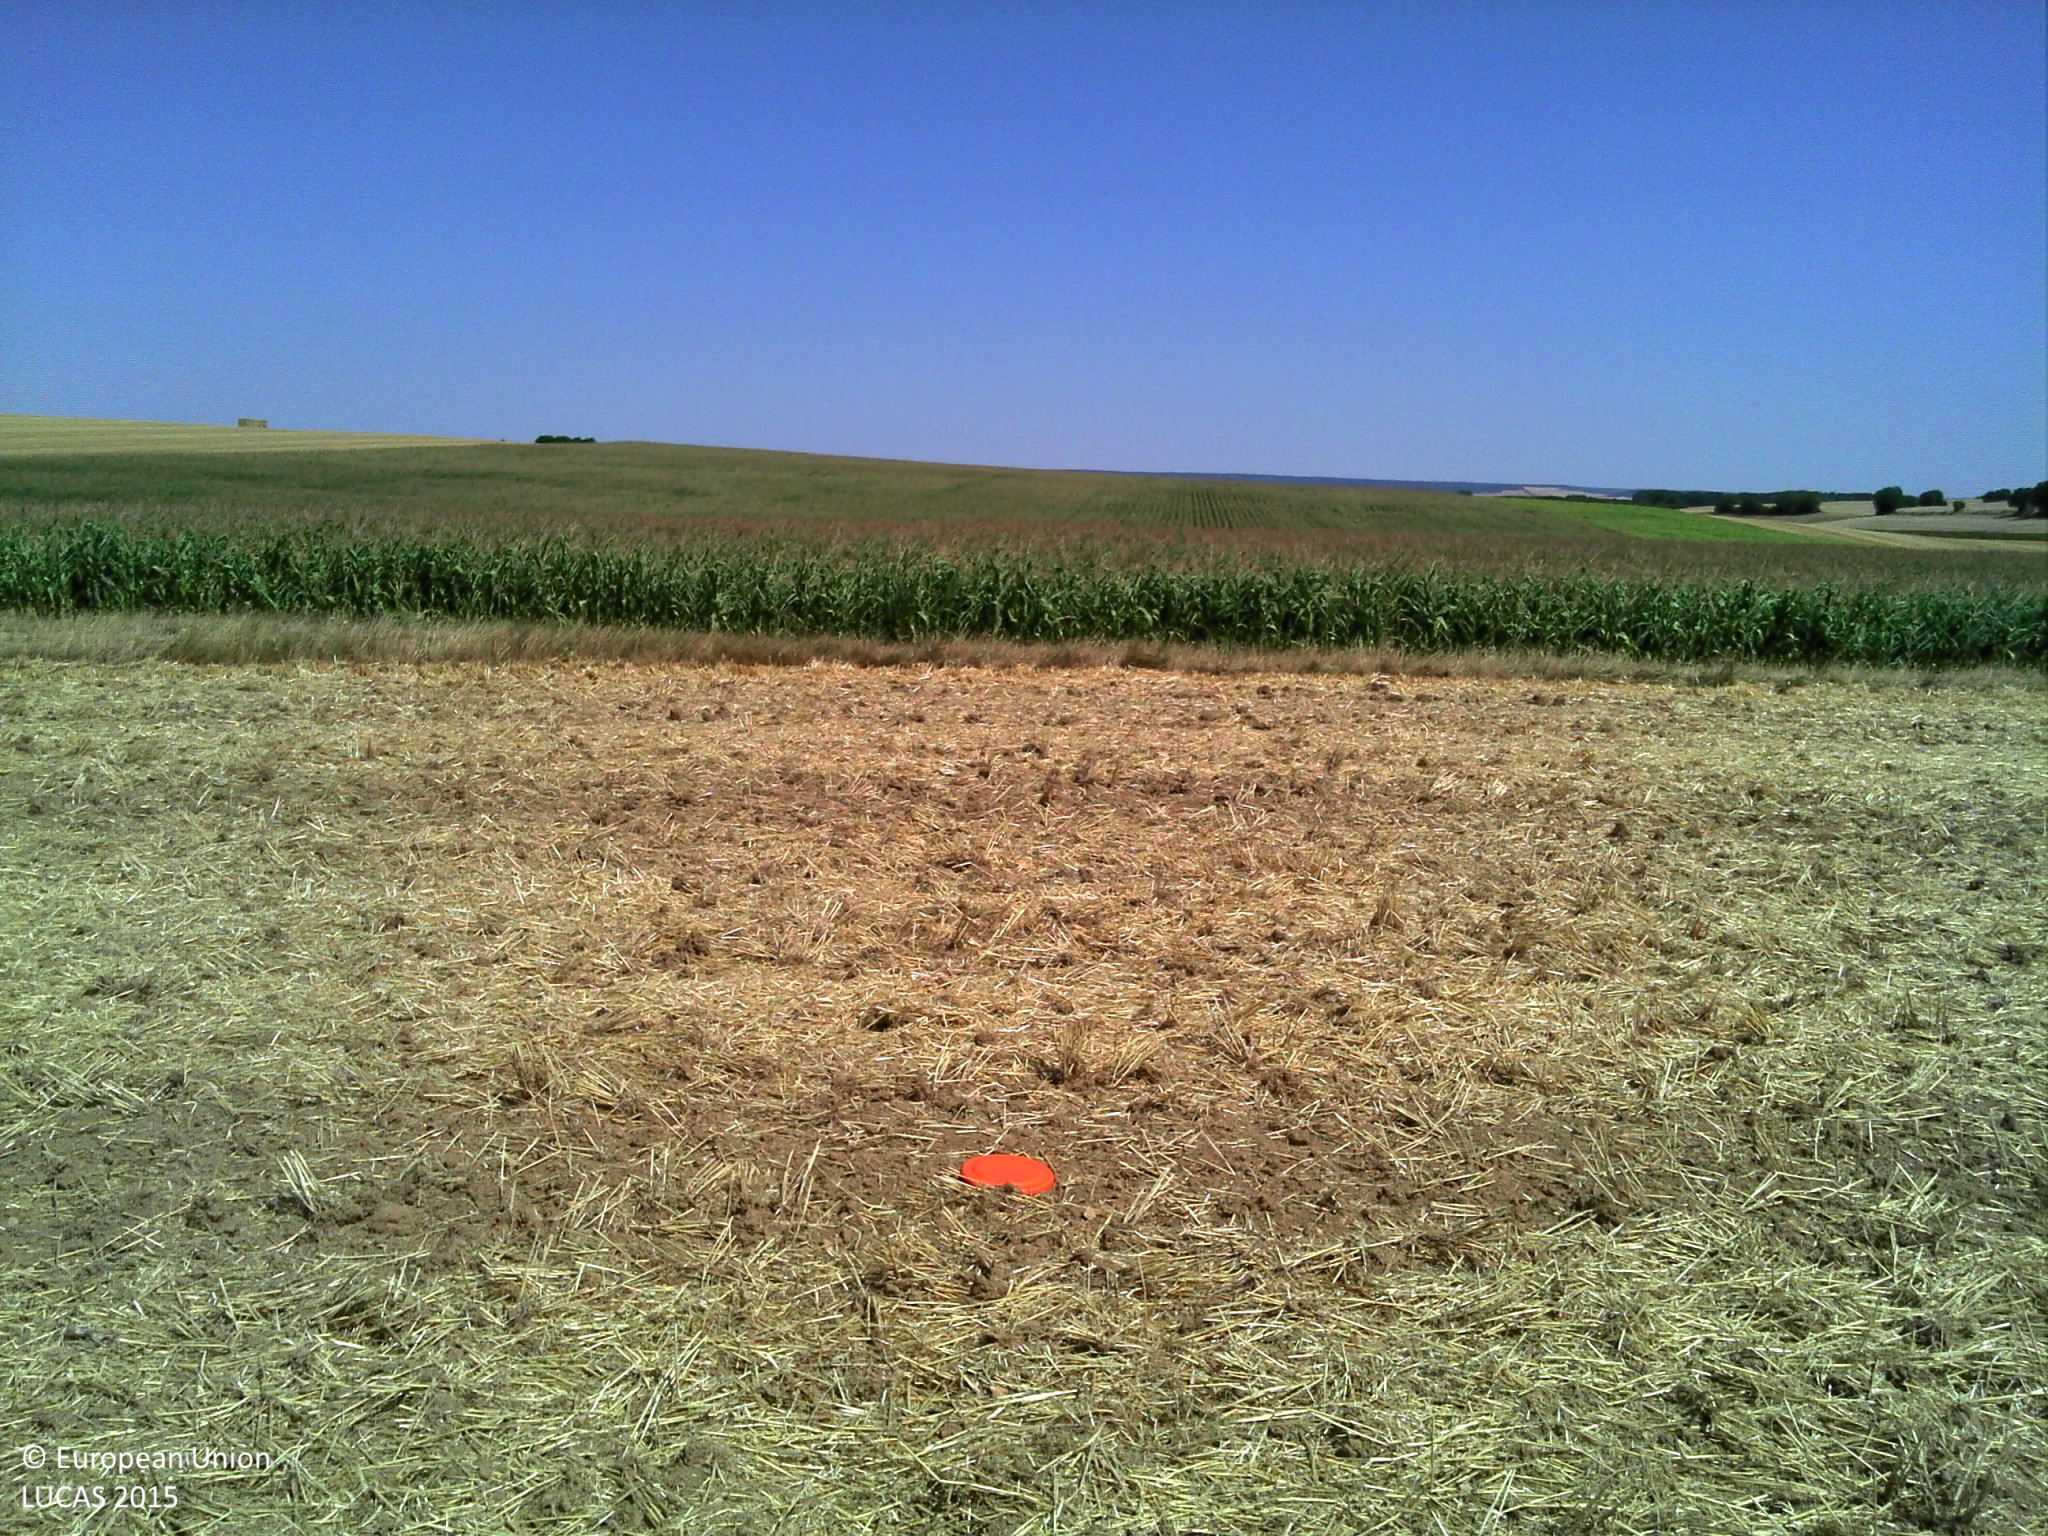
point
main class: Cropland
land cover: Common wheat
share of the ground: > 75 %
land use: Agriculture (excluding fallow land and kitchen gardens)
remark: Tilled/Sowed
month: August
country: FR
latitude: 47.9189
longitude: 3.4245
